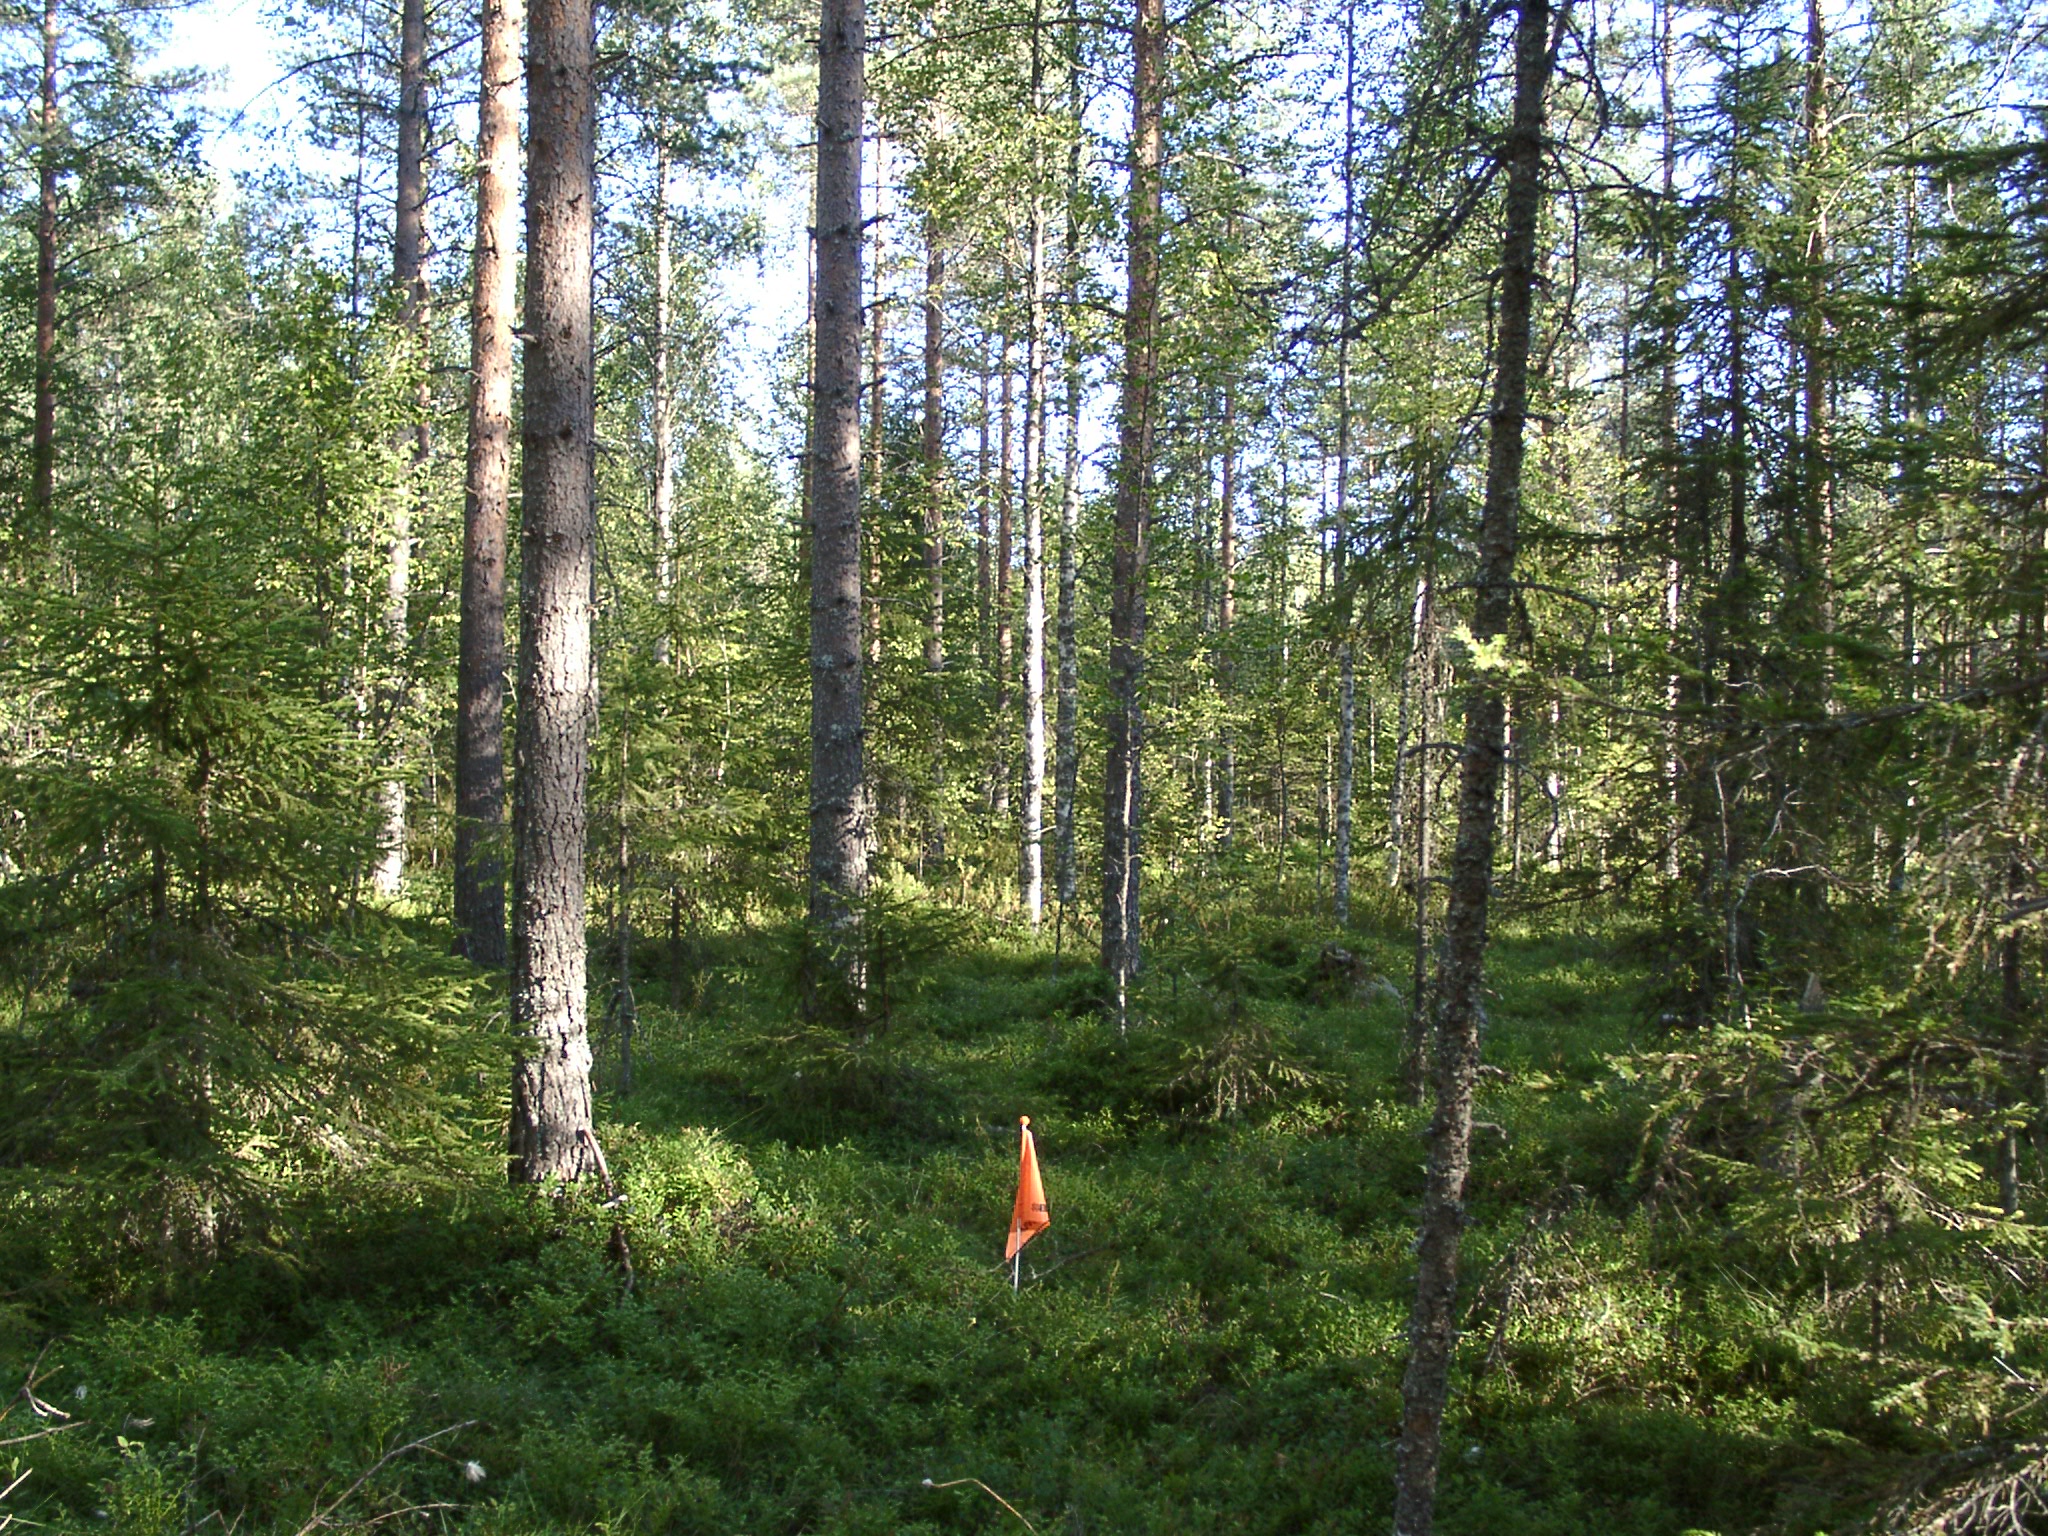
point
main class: Woodland
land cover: Other mixed woodland
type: boreal forest
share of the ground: 50 - 75 %
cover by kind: coniferous forest trees 50 %, shrubs 25 %, broadleaved forest trees 20 %, lichens and mosses 5 %
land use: Forestry
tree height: > 5 m
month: August
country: FI
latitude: 62.4286
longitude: 25.1520
